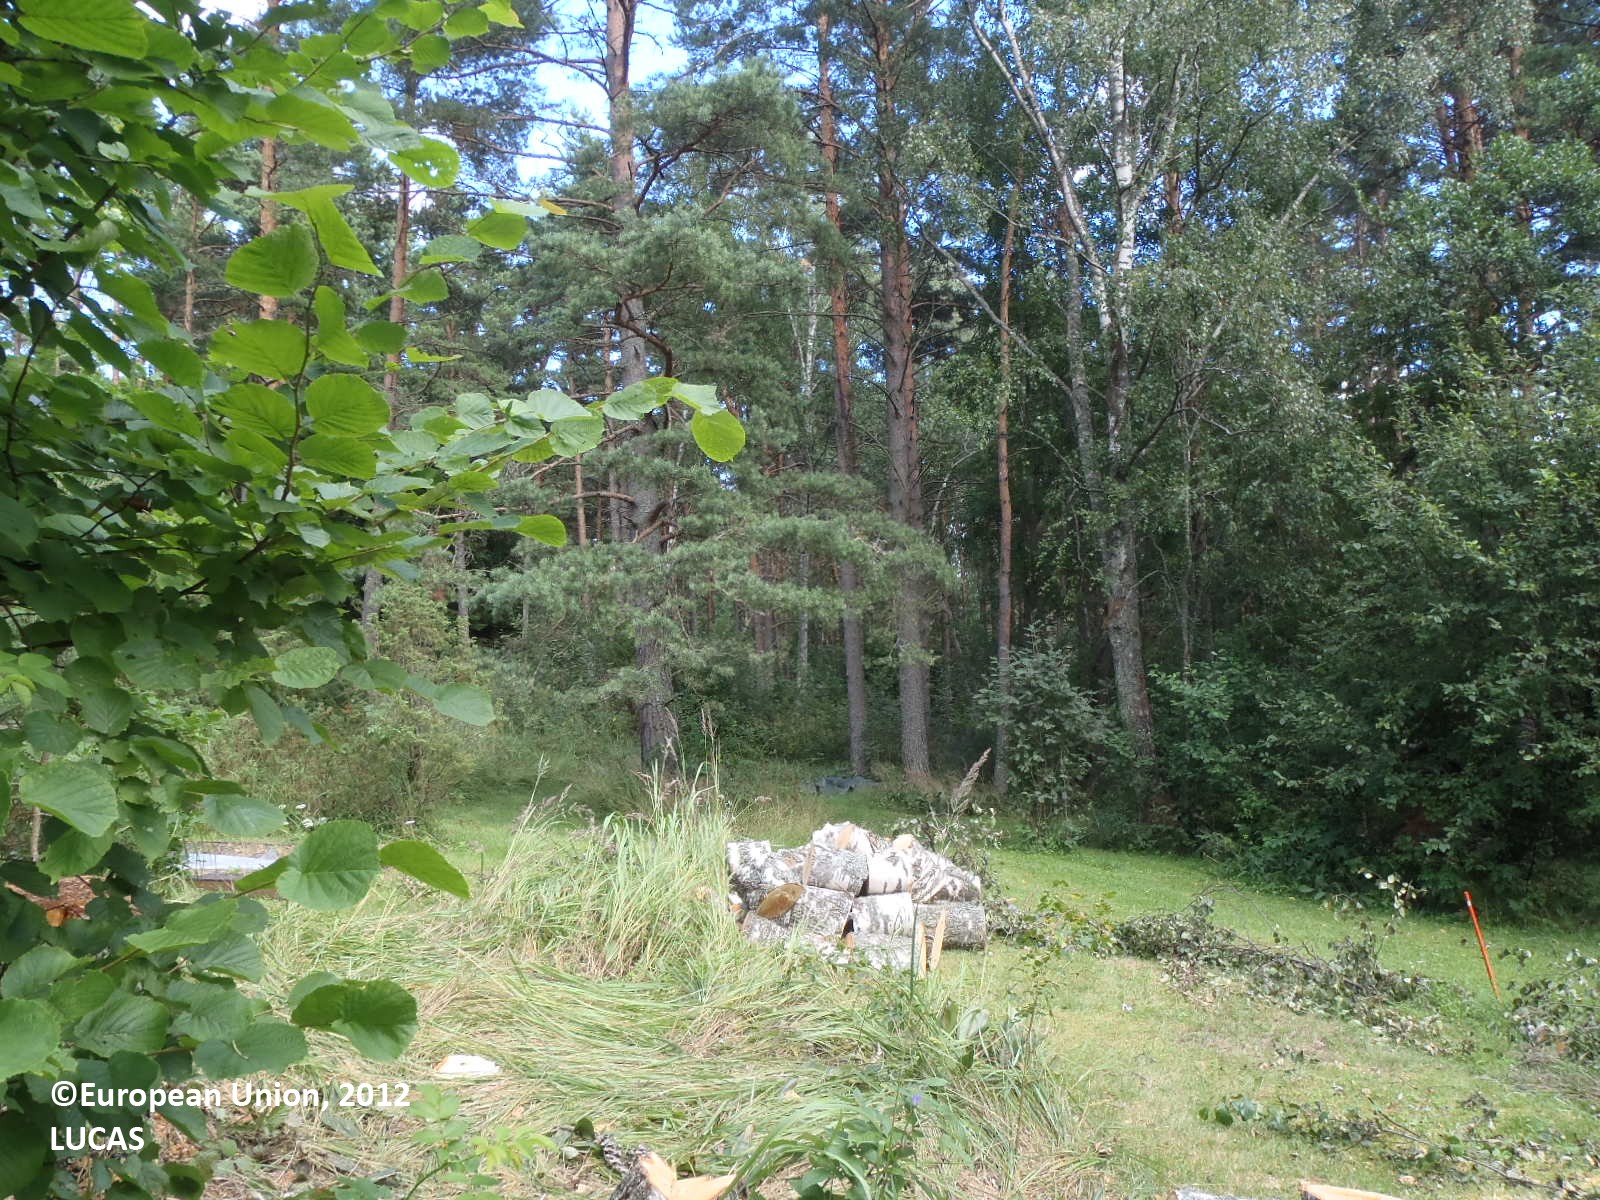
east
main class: Woodland
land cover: Pine dominated mixed woodland
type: boreal forest
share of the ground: 25 - 50 %
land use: Residential
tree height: > 5 m
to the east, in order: Pine dominated mixed woodland; Broadleaved woodland; Pine dominated coniferous woodland; Tracks; Pine dominated coniferous woodland; Paved roads, cycling and walking lanes; Pine dominated mixed woodland; Ditches and canals; Pine dominated coniferous woodland
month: August
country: FI
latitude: 60.1552
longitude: 21.8264
